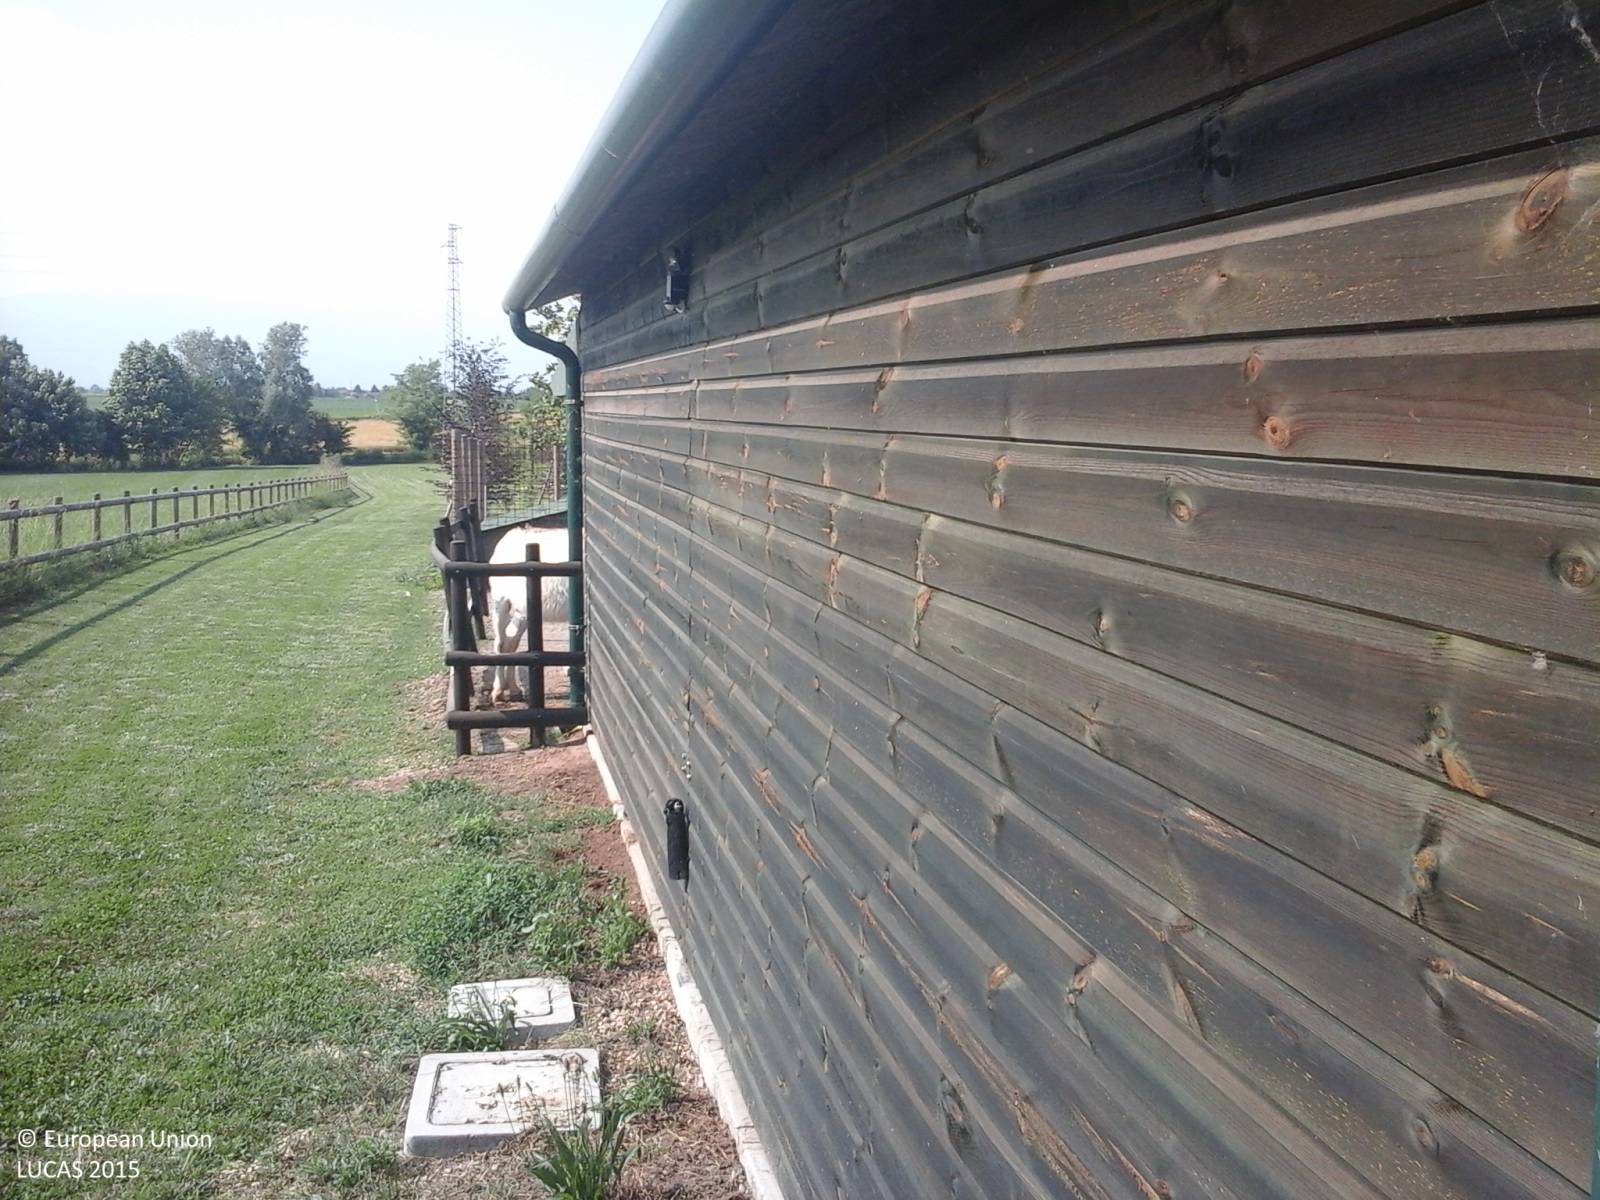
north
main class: Grassland
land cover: Grassland without tree/shrub cover
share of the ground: > 75 %
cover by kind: herbaceous plants 100 %
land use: Residential
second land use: Agriculture (excluding fallow land and kitchen gardens)
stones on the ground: < 10 %
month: June
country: IT
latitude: 45.8700
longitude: 12.5602
